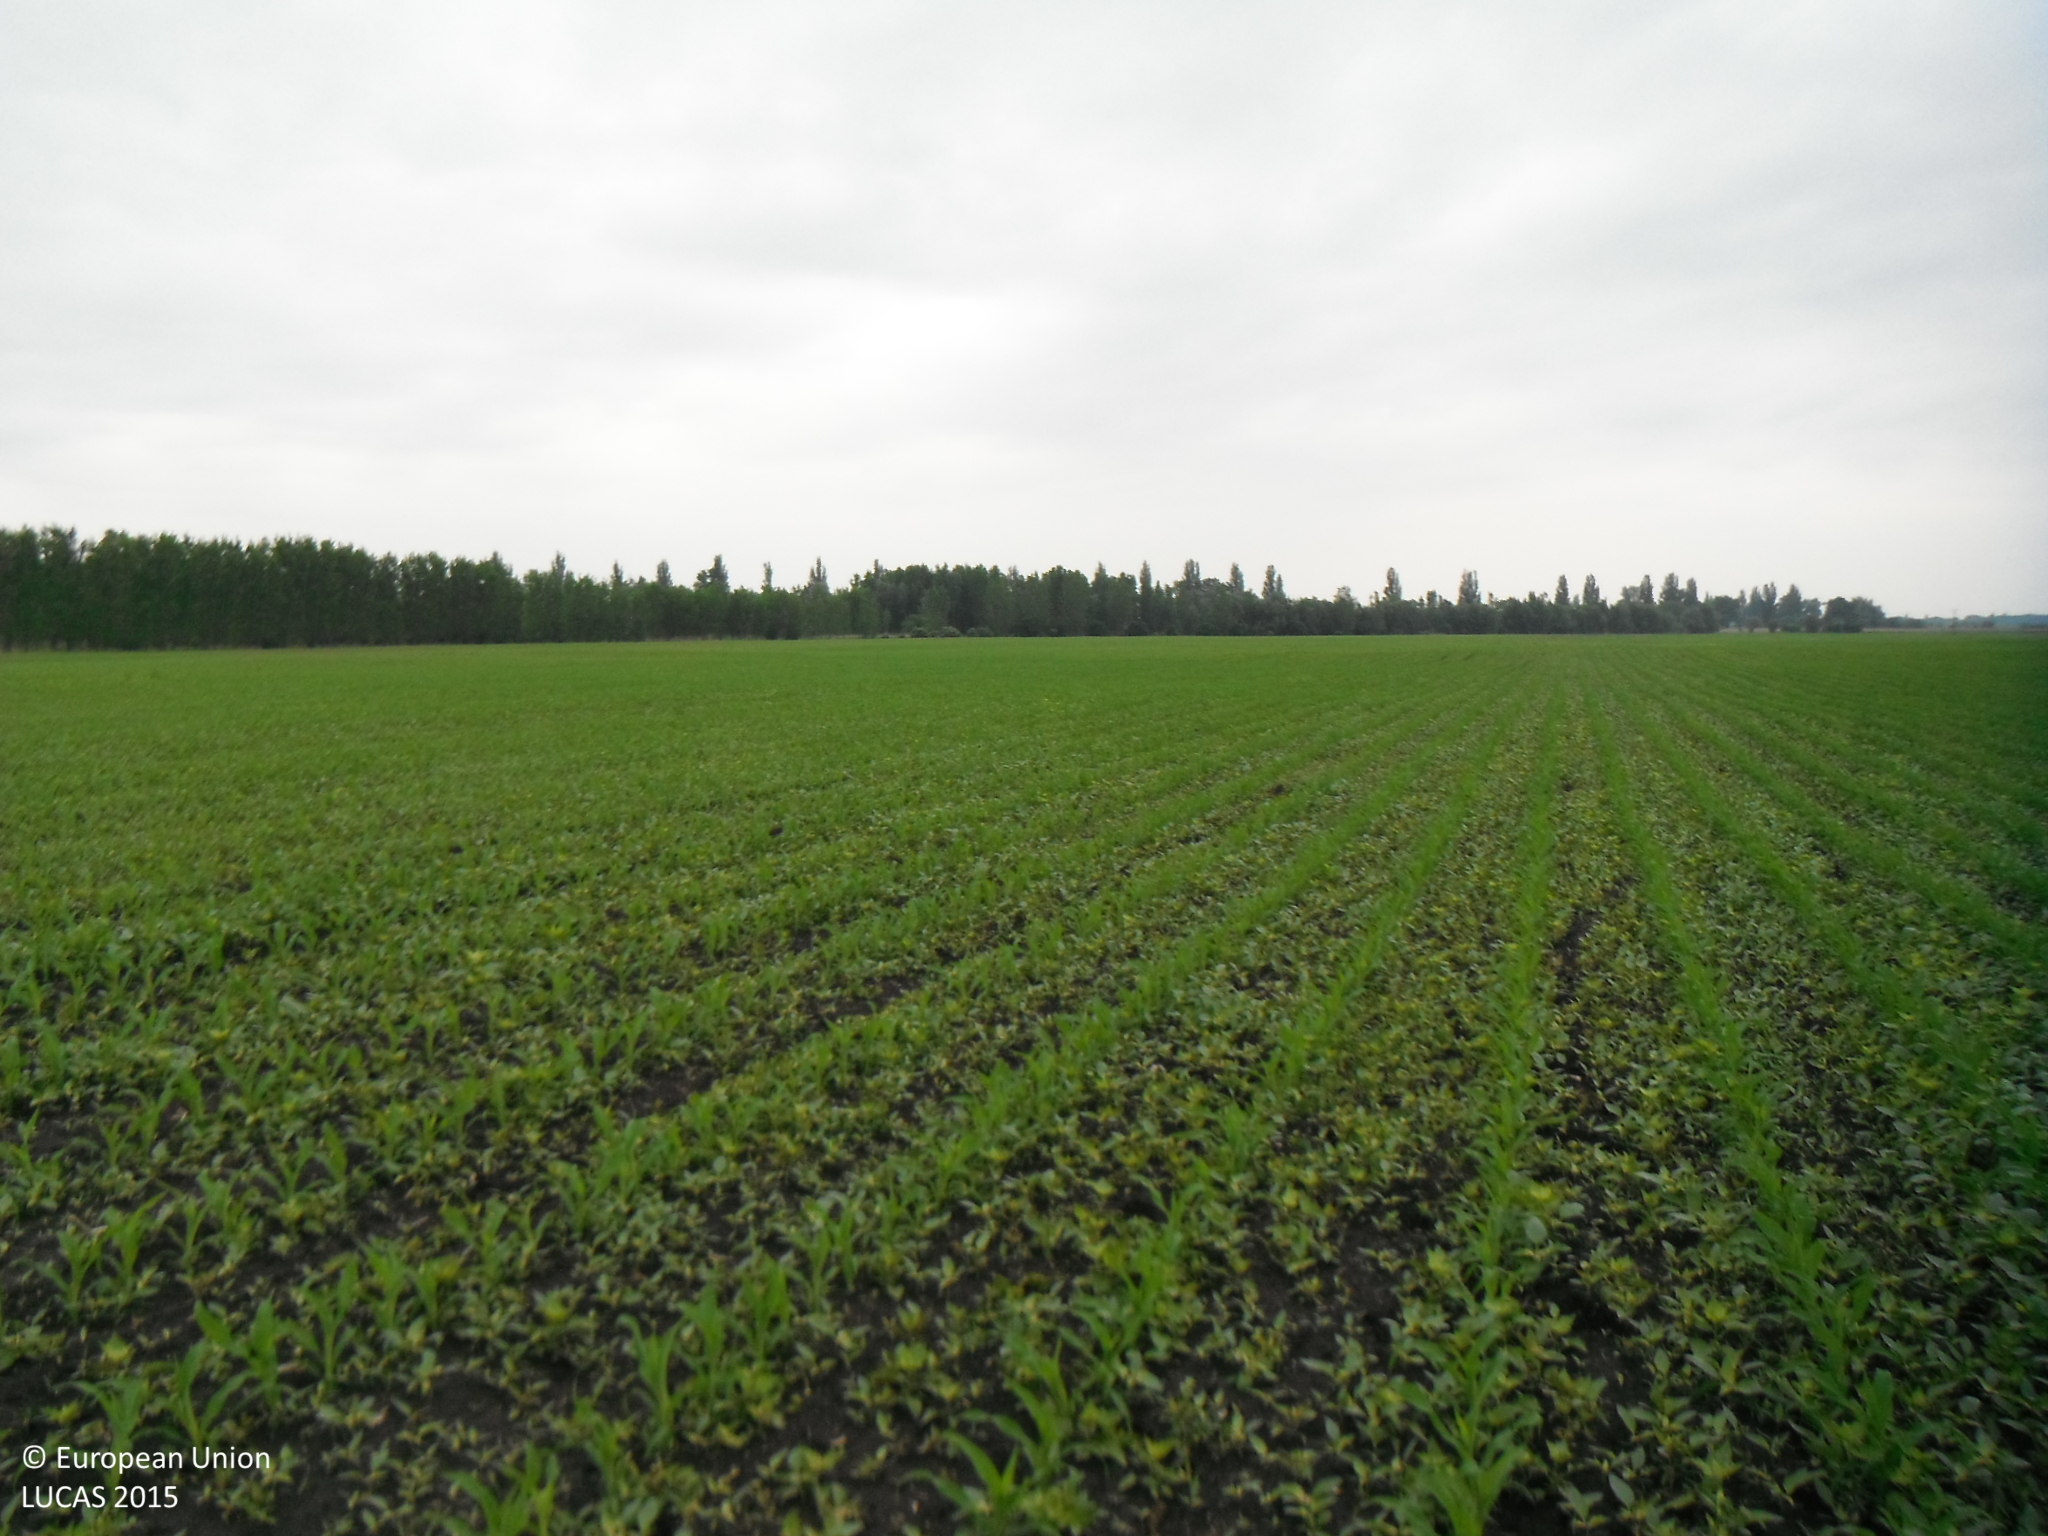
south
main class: Cropland
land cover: Maize
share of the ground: 25 - 50 %
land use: Agriculture (excluding fallow land and kitchen gardens)
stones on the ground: < 10 %
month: May
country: SK
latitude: 47.9298
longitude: 17.7872
